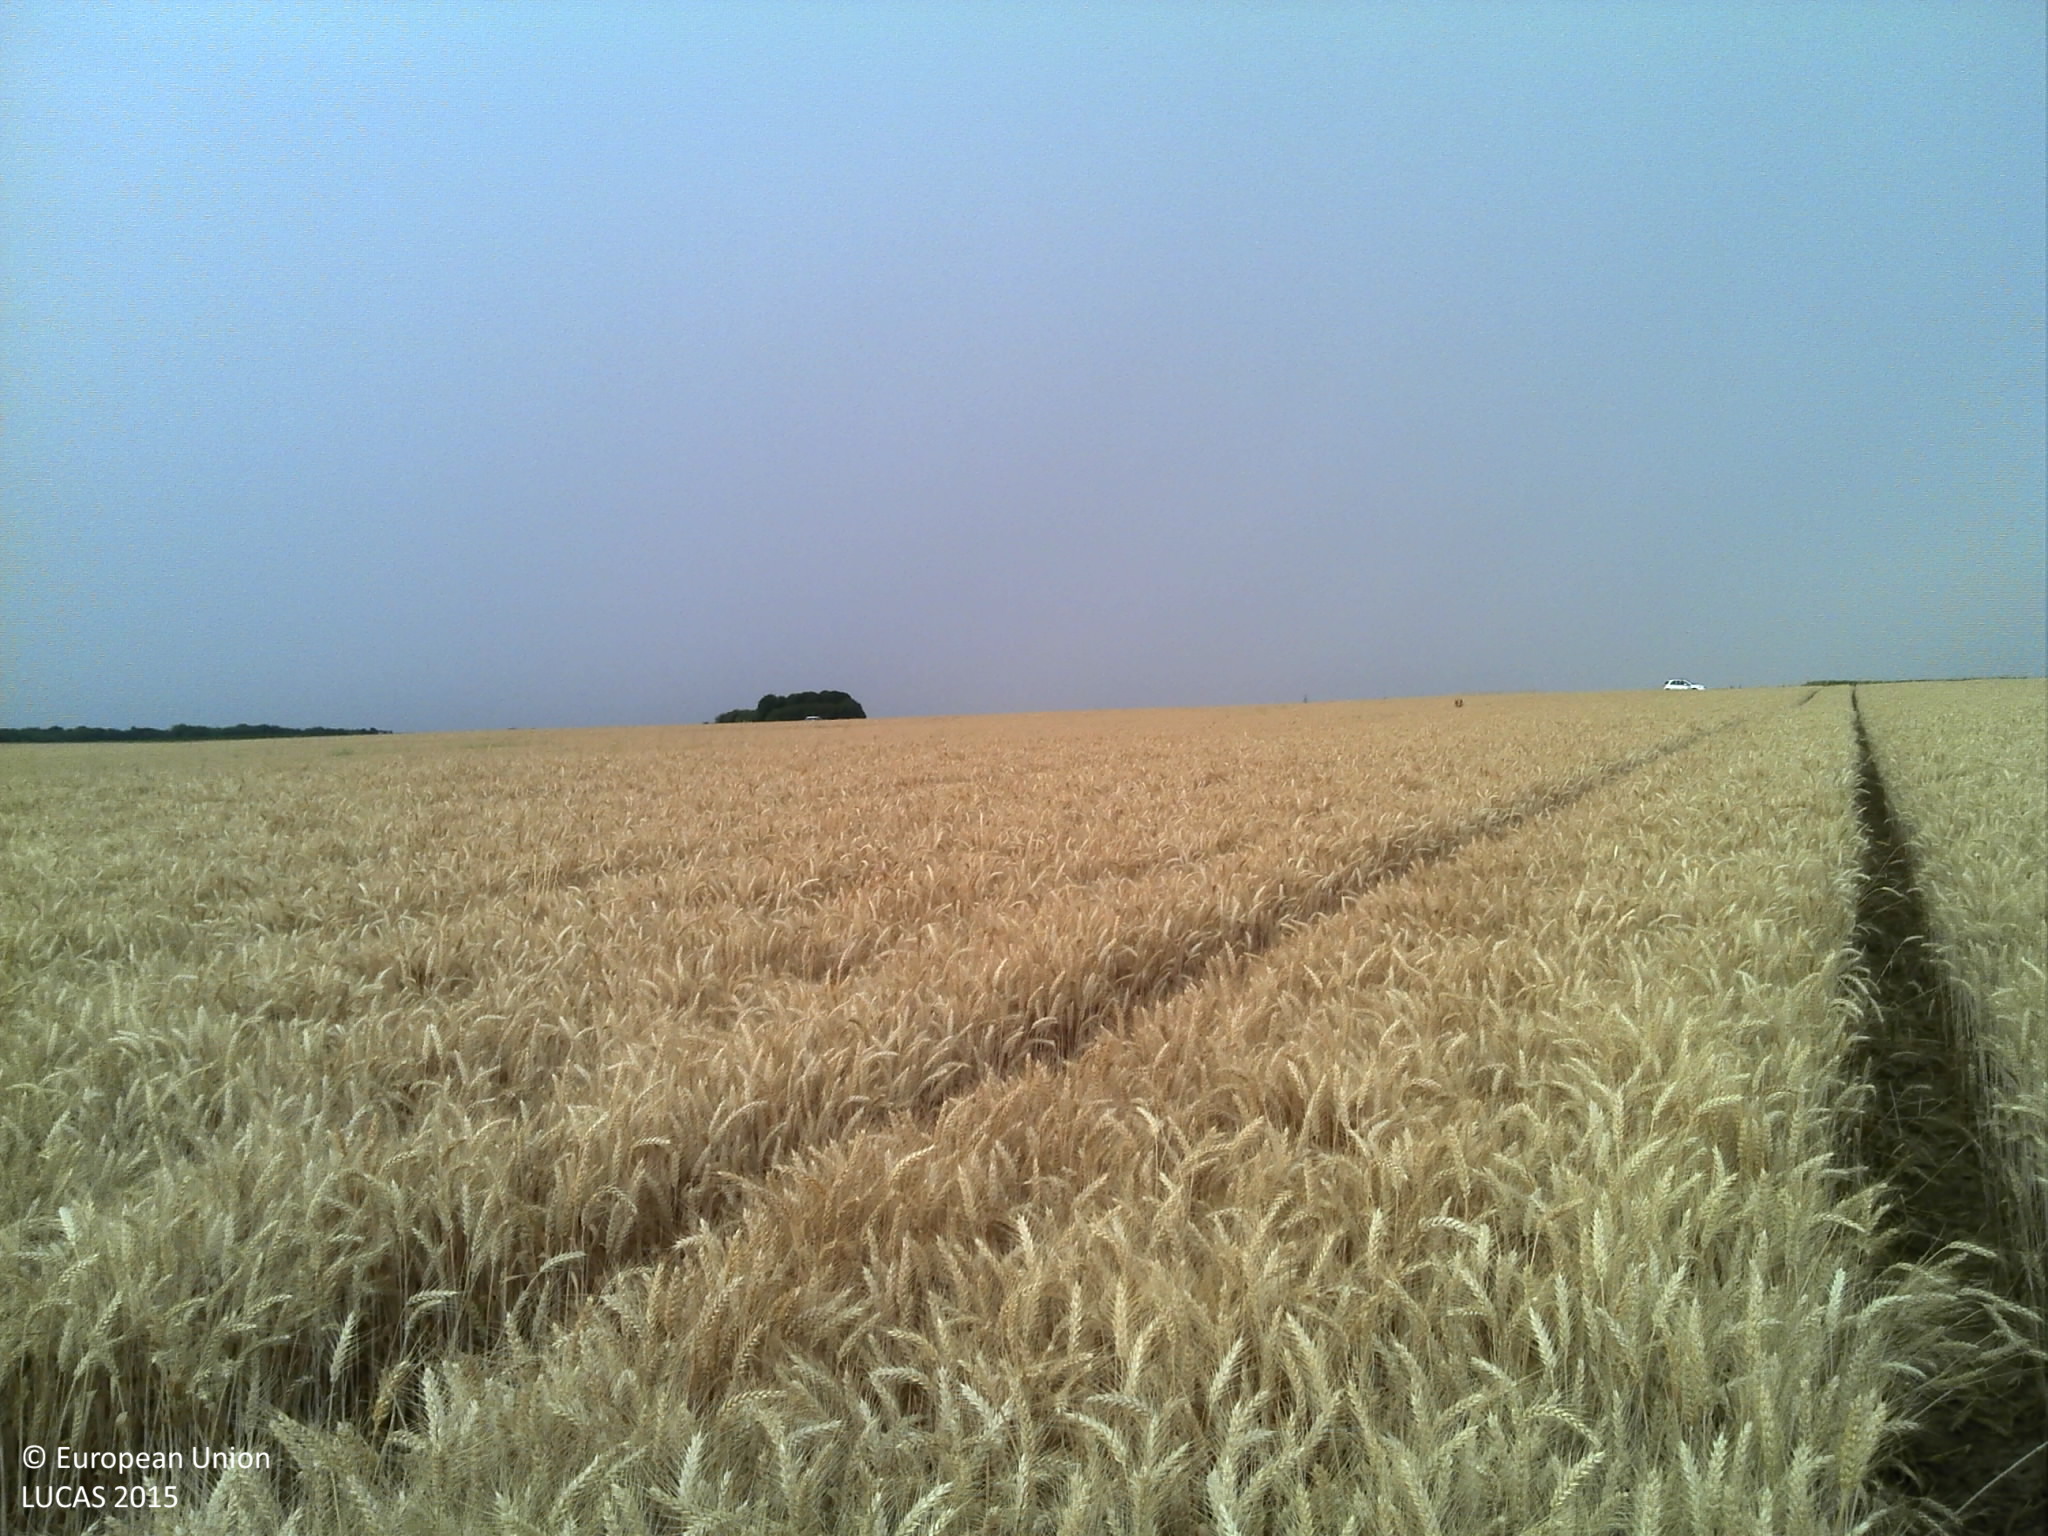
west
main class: Cropland
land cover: Durum wheat
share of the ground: > 75 %
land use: Agriculture (excluding fallow land and kitchen gardens)
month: July
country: FR
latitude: 48.3259
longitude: 2.4499
